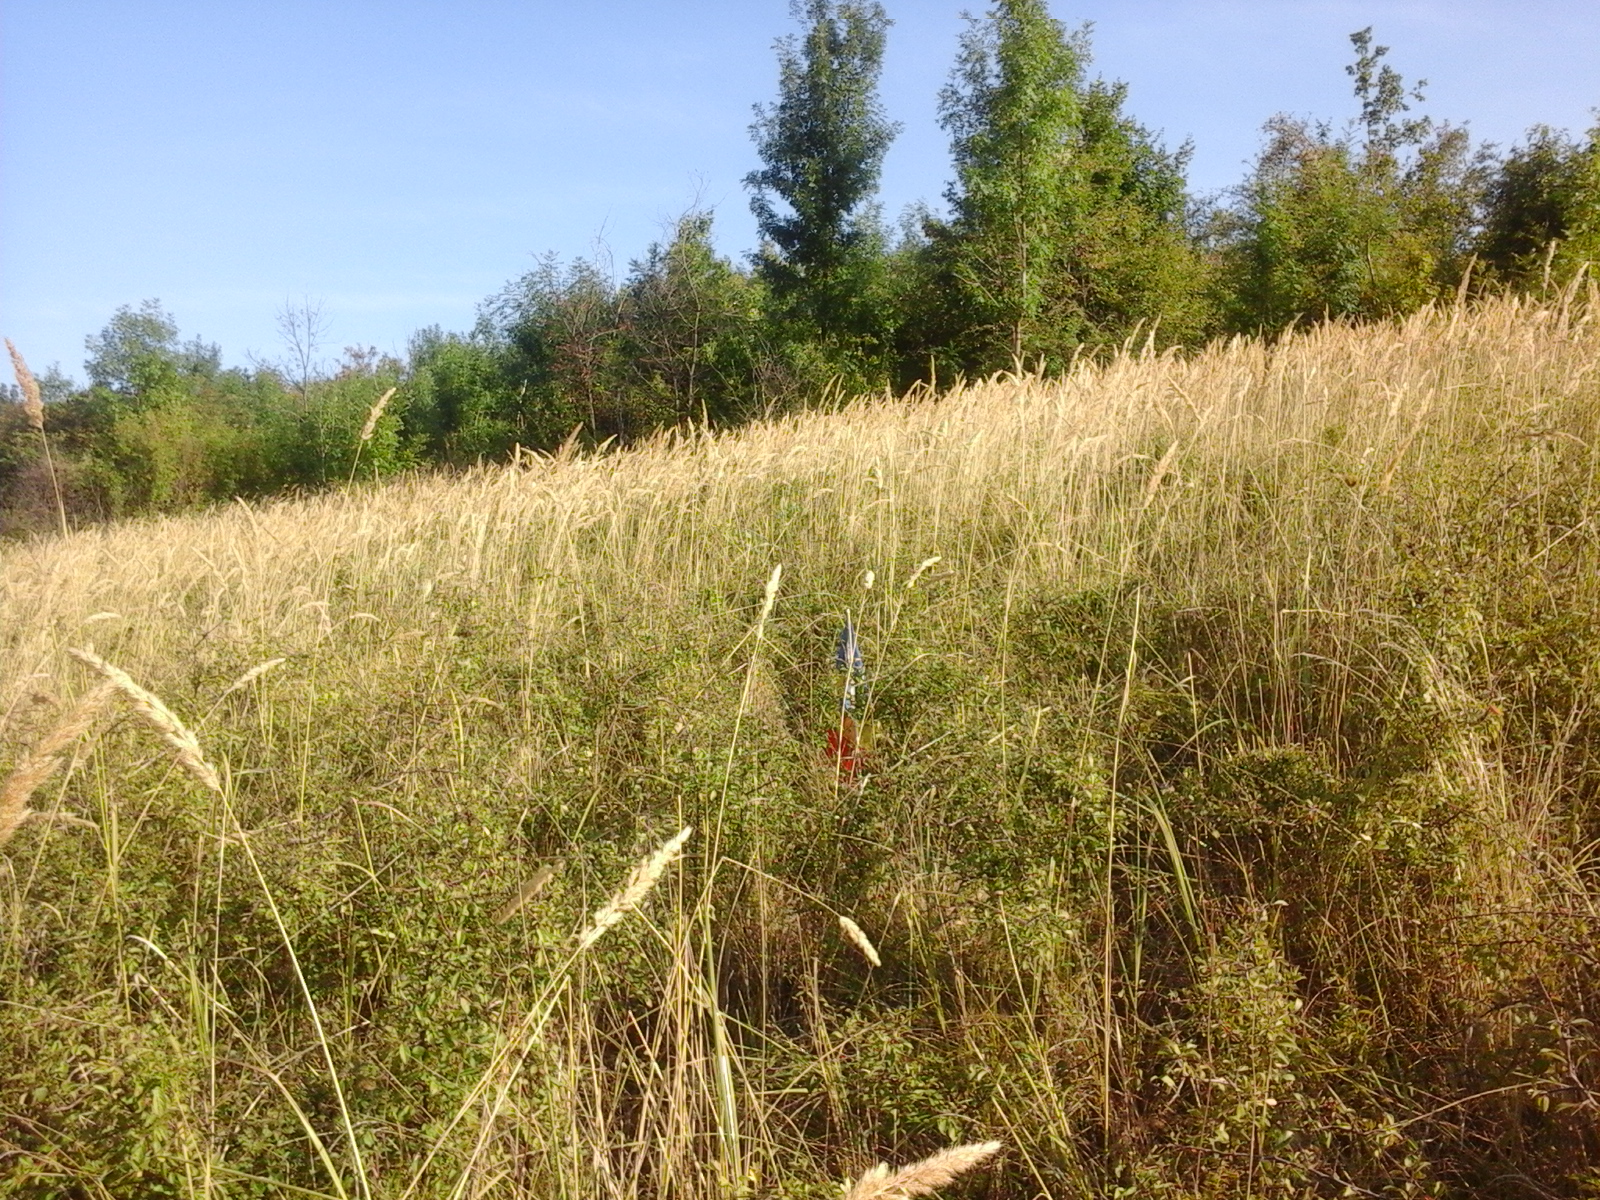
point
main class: Grassland
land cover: Grassland with sparse tree/shrub cover
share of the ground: > 75 %
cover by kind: herbaceous plants 95 %, broadleaved forest trees 5 %
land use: Agriculture (excluding fallow land and kitchen gardens)
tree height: < 5 m
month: August
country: RO
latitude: 45.2928
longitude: 21.4941
